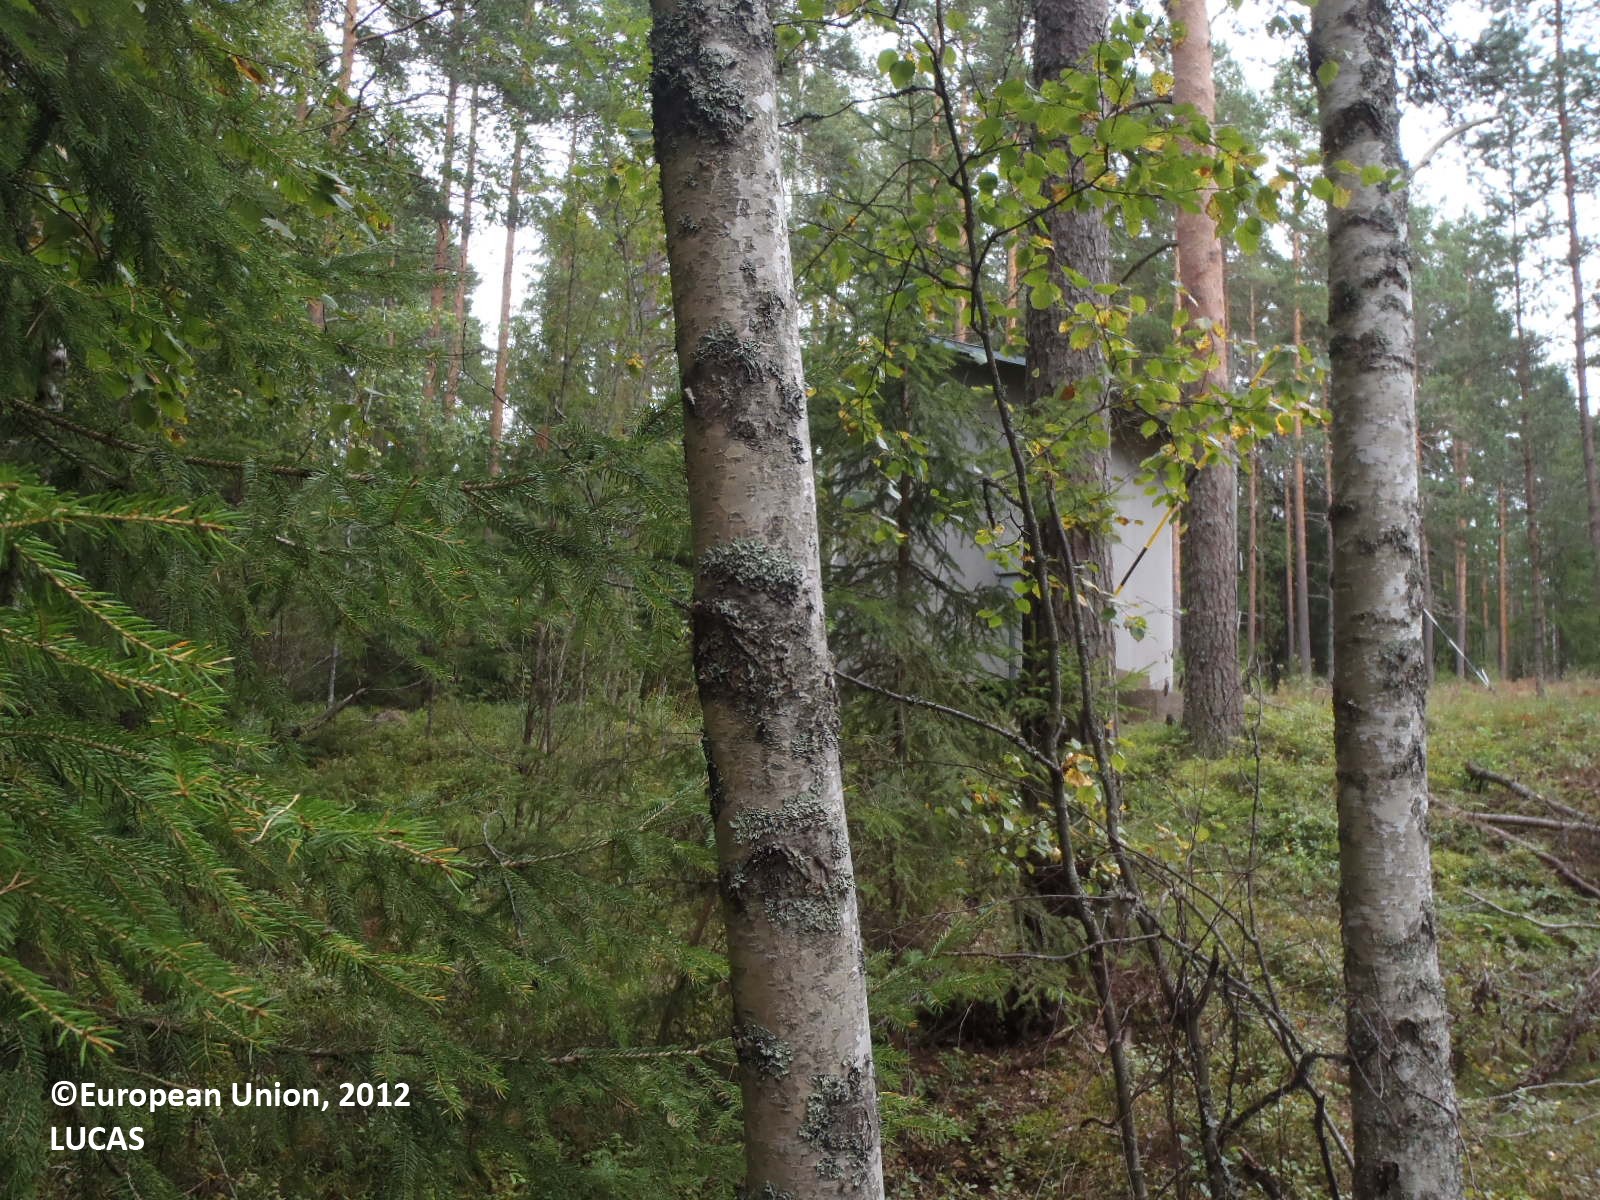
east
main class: Woodland
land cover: Pine dominated mixed woodland
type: boreal forest
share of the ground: > 75 %
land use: Forestry
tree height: > 5 m
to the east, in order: Pine dominated mixed woodland; Pine dominated coniferous woodland; Electric lines; Pine dominated coniferous woodland; Paved roads, cycling and walking lanes; Pine dominated coniferous woodland
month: August
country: FI
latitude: 60.8863
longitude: 22.2430
